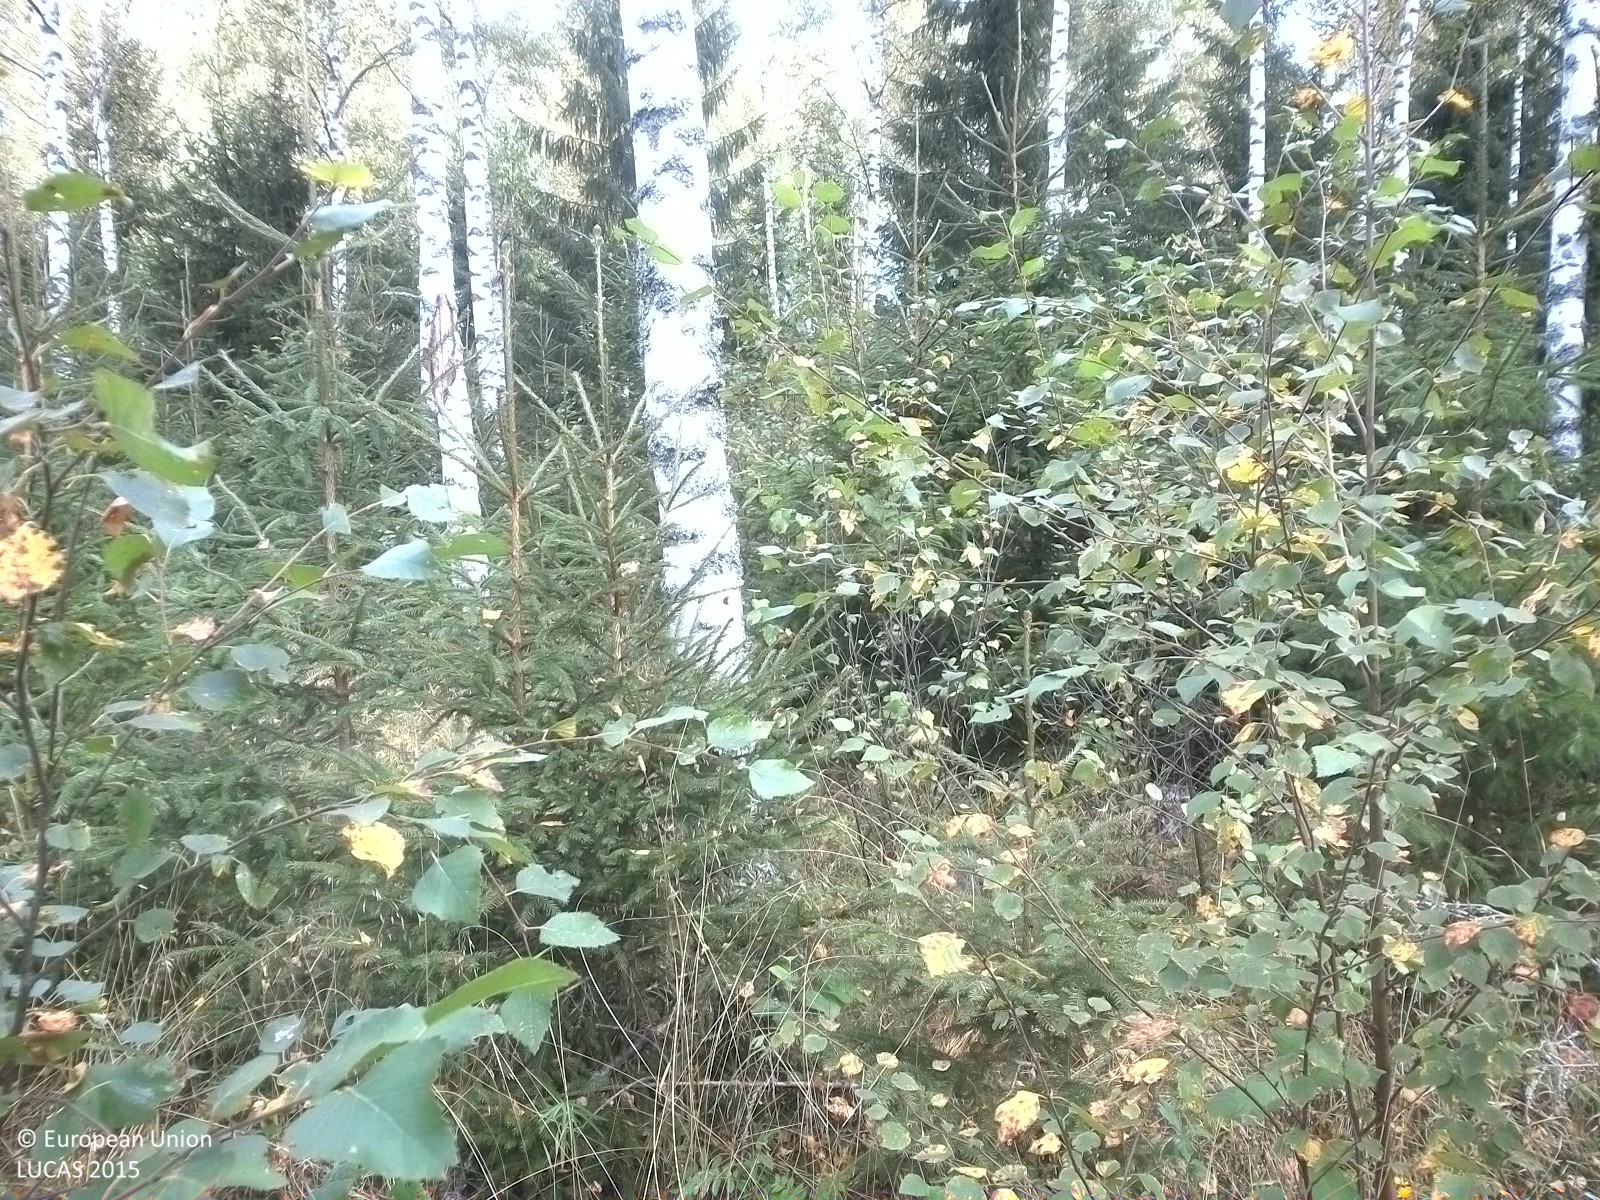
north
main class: Woodland
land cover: Spruce dominated mixed woodland
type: boreal forest
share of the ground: 50 - 75 %
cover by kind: herbaceous plants 35 %, coniferous forest trees 30 %, broadleaved forest trees 30 %, lichens and mosses 5 %
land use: Forestry
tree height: > 5 m
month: August
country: SE
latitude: 58.6849
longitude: 15.0130
